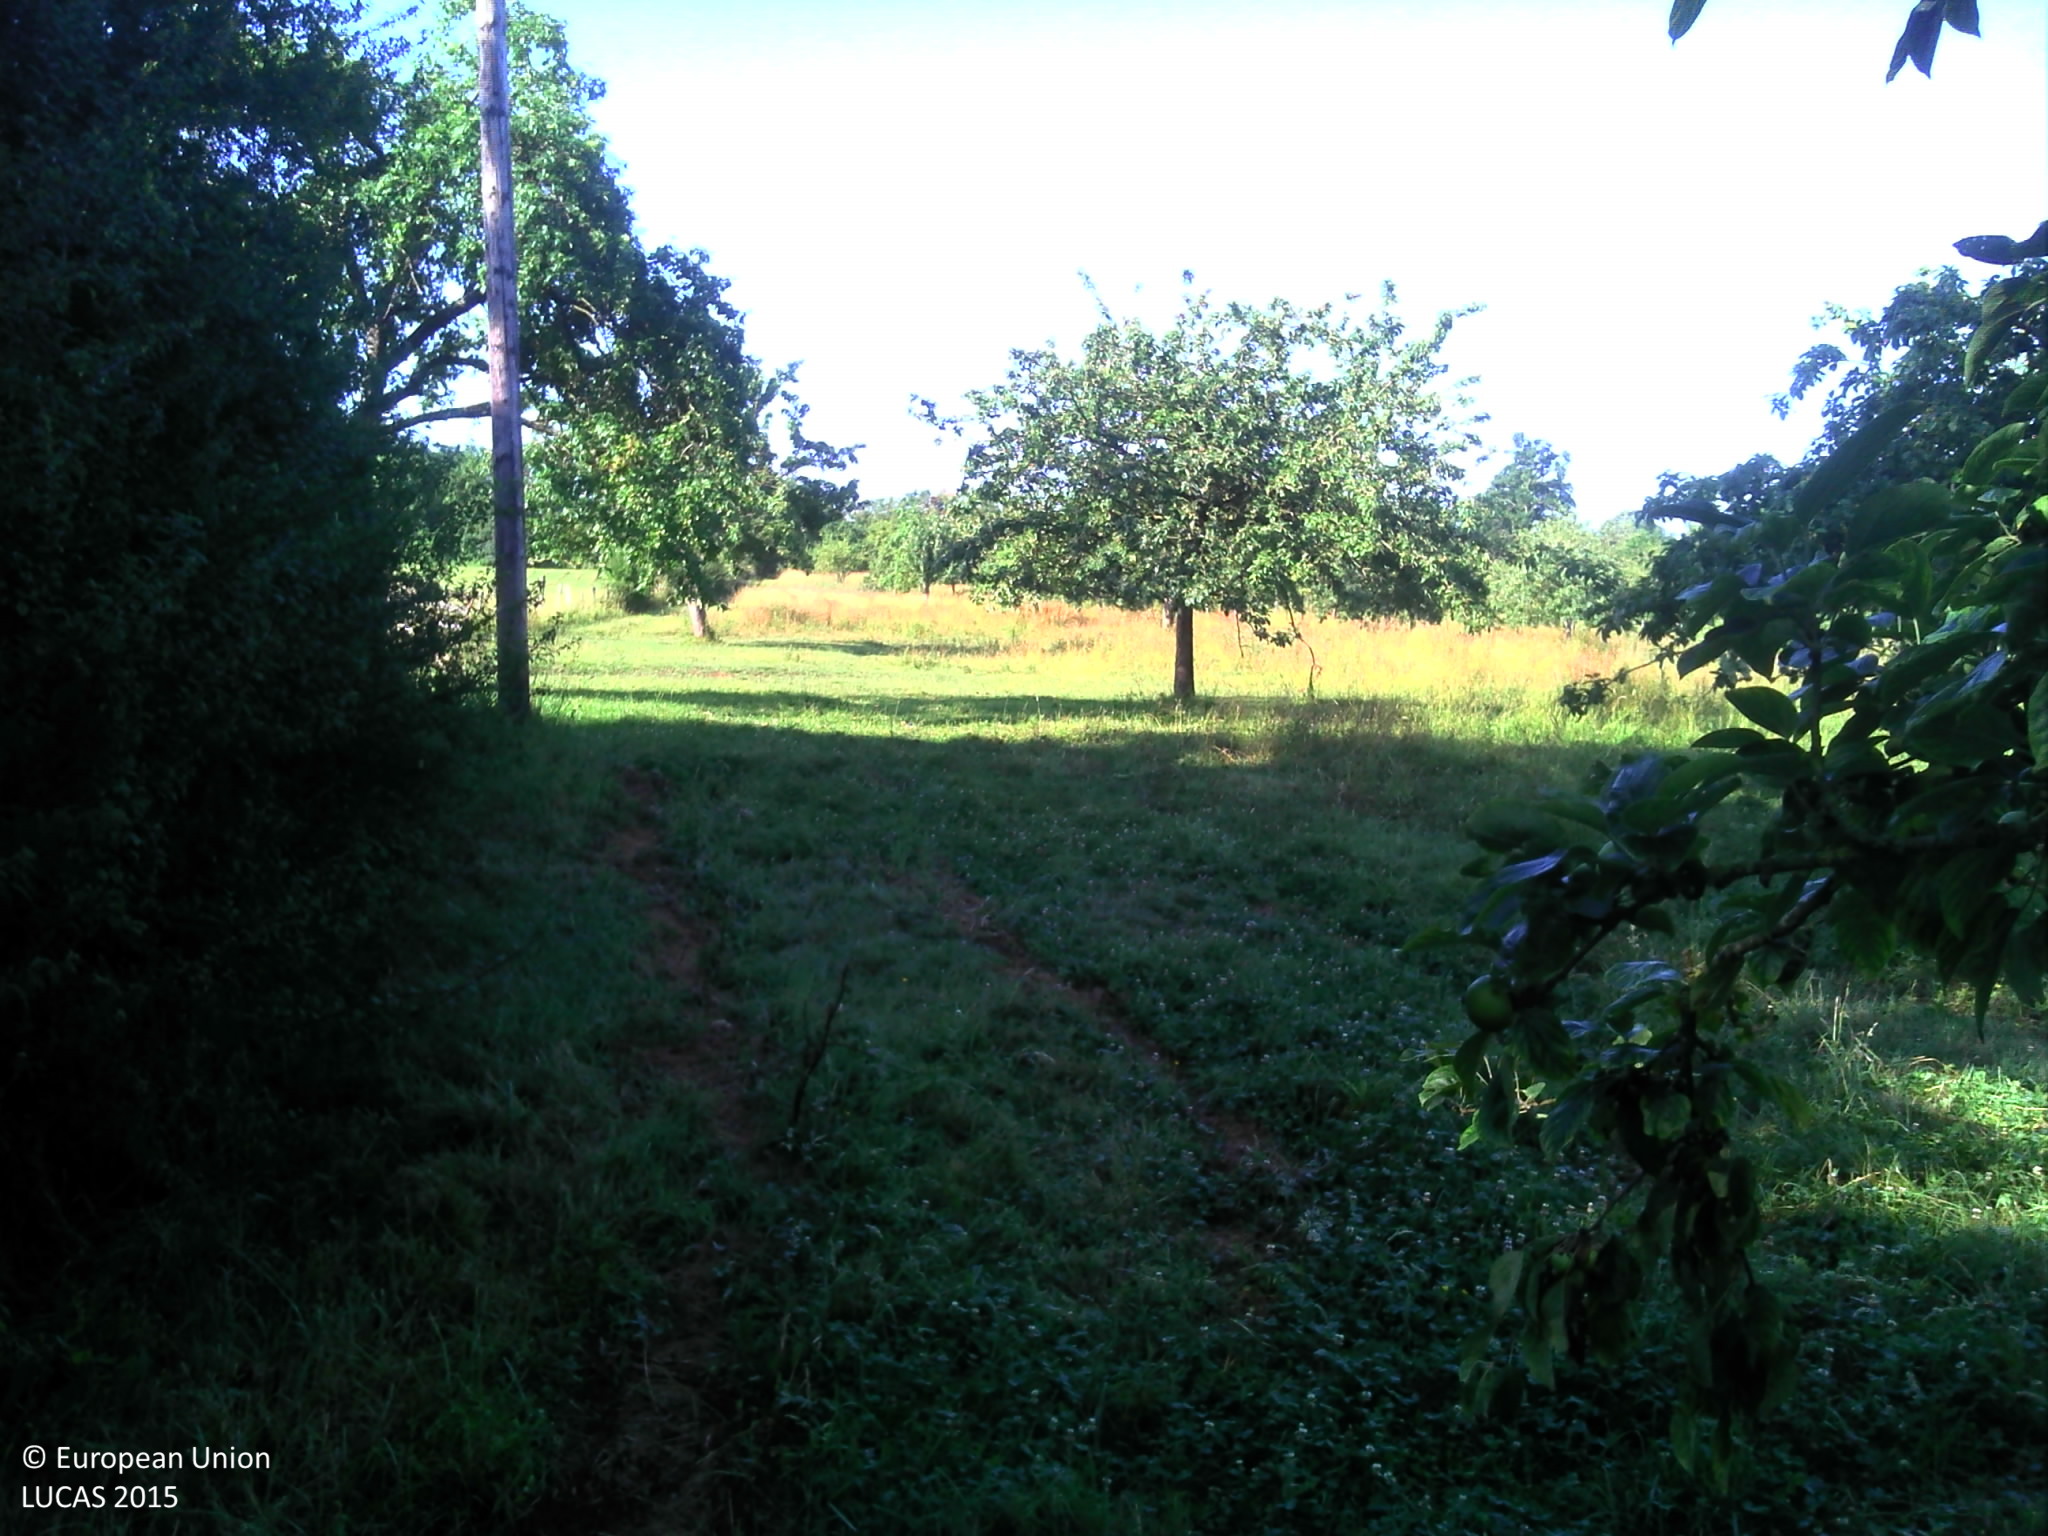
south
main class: Cropland
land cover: Apple fruit
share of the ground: 10 - 25 %
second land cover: Grassland without tree/shrub cover
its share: > 75 %
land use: Agriculture (excluding fallow land and kitchen gardens)
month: July
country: FR
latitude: 49.0365
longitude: -0.0027
